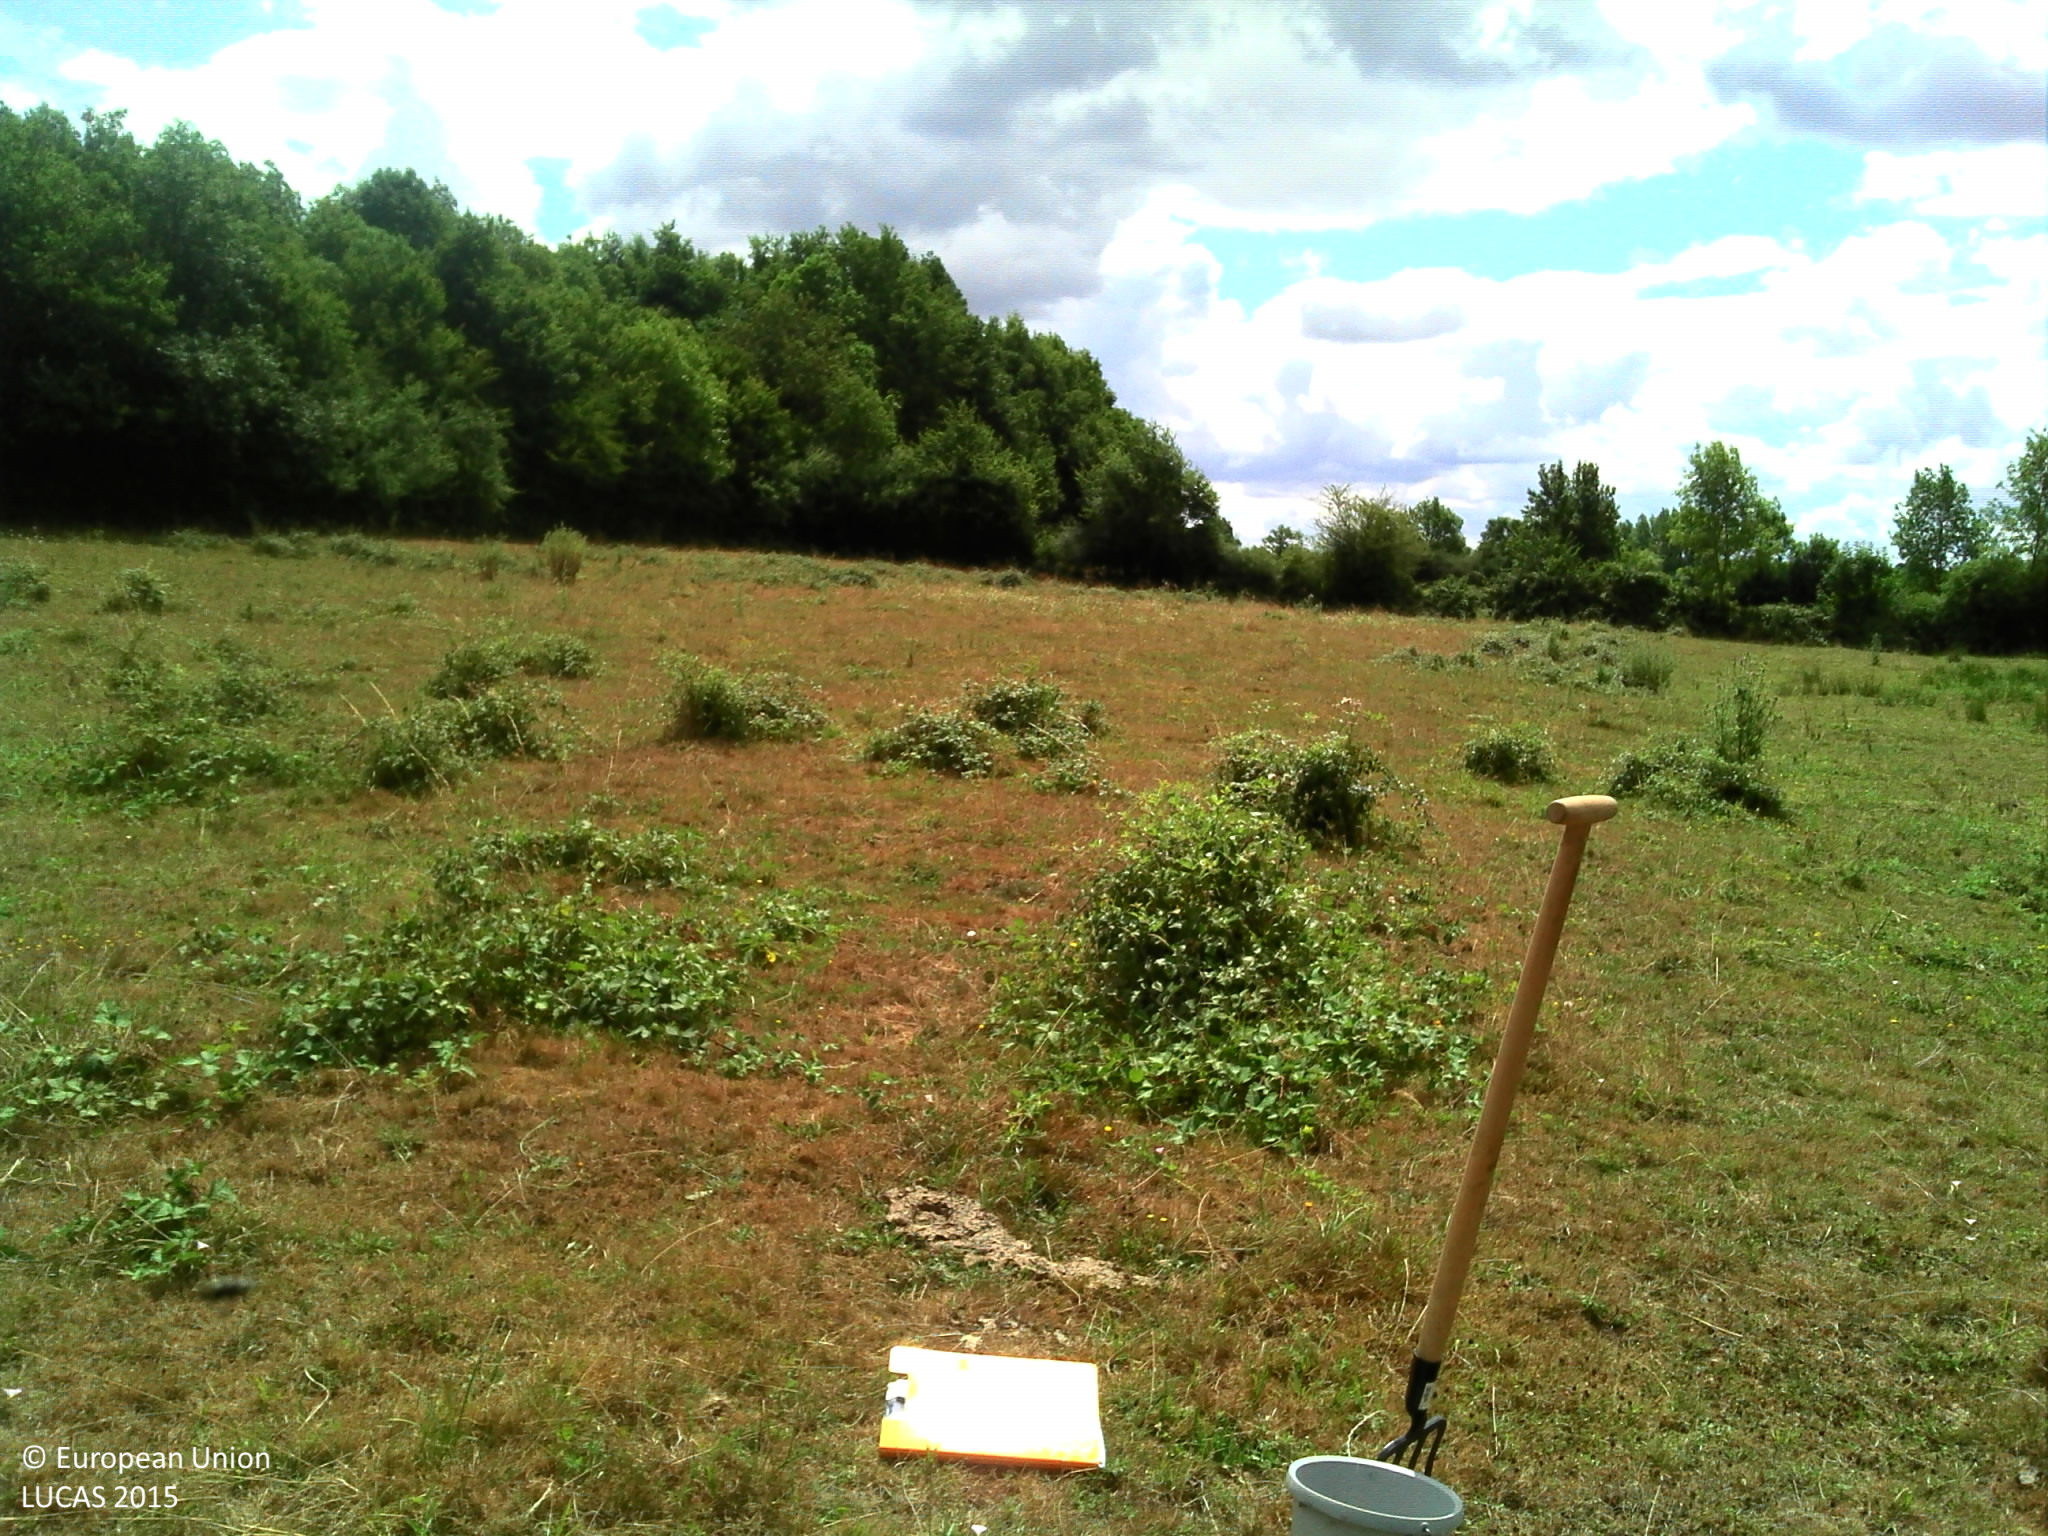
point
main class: Grassland
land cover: Grassland without tree/shrub cover
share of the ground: > 75 %
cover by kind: herbaceous plants 100 %
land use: Agriculture (excluding fallow land and kitchen gardens)
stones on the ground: < 10 %
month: July
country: FR
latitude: 46.7161
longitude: 2.1828
